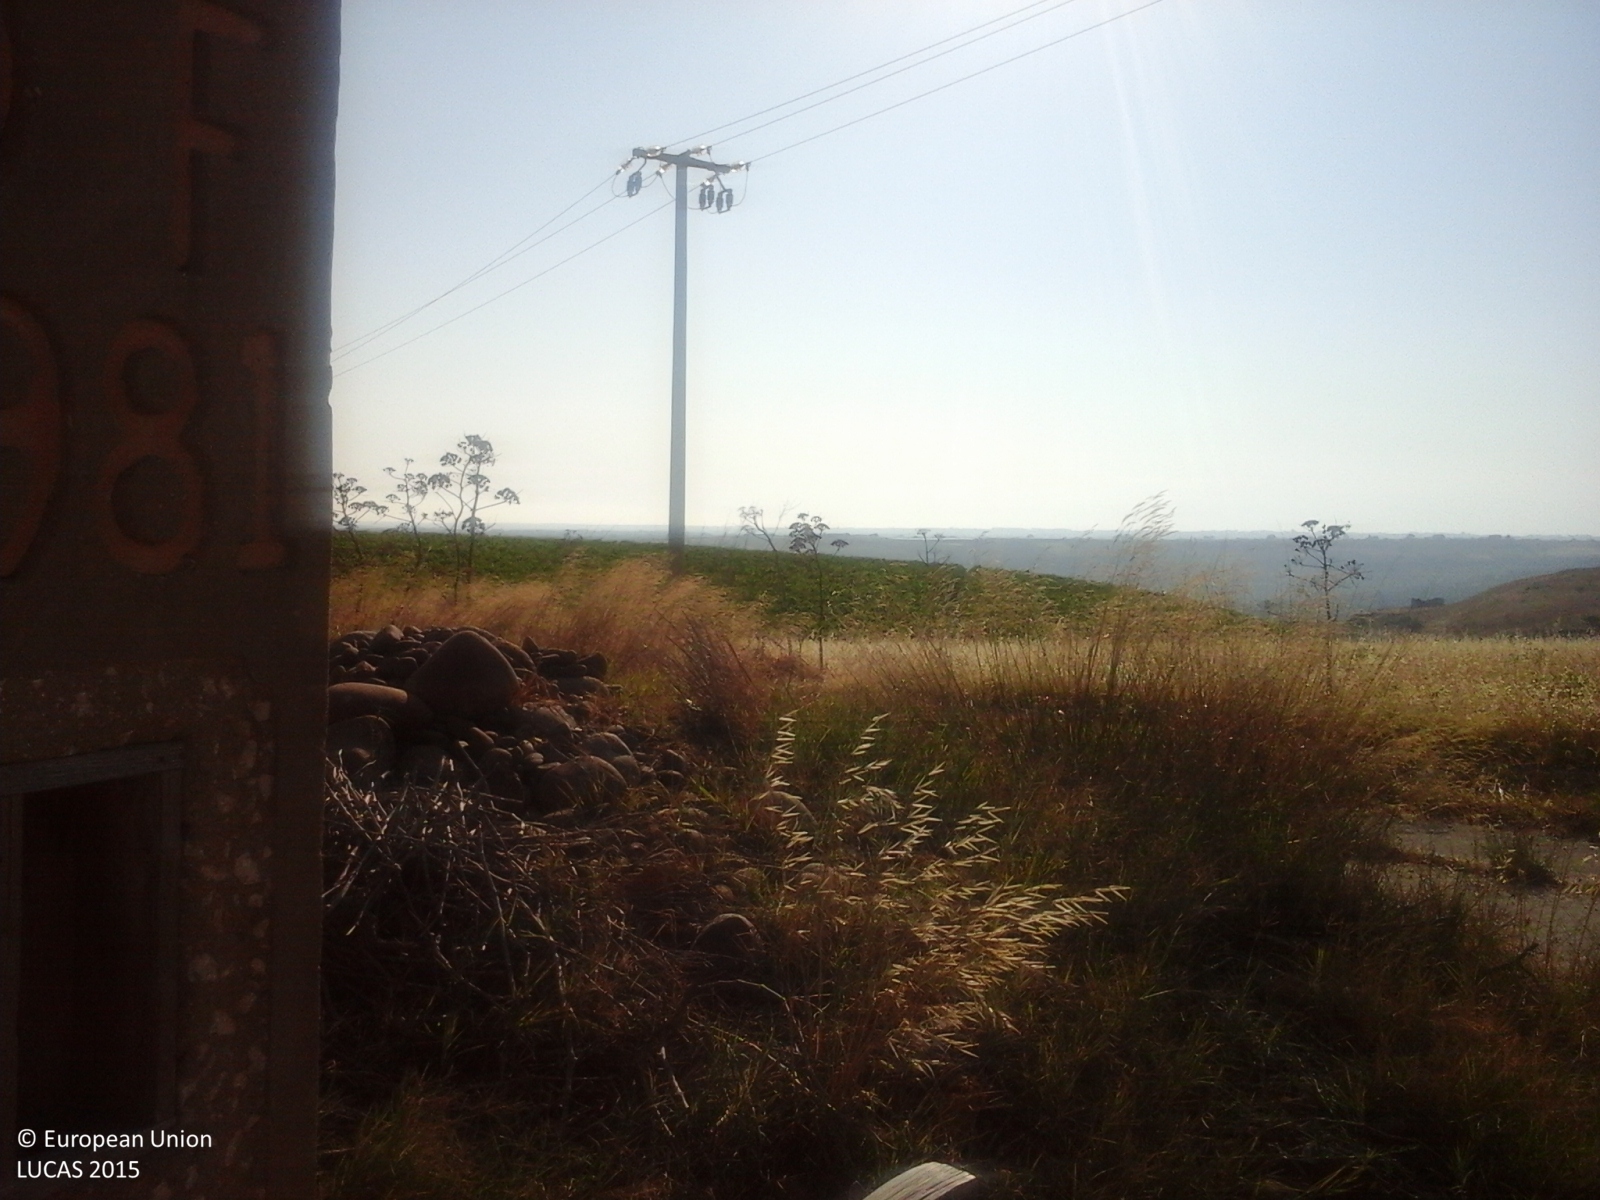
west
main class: Cropland
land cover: Vineyards
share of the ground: 25 - 50 %
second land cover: Other bare soil
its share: > 75 %
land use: Agriculture (excluding fallow land and kitchen gardens)
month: June
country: IT
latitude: 37.6484
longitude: 12.9134
